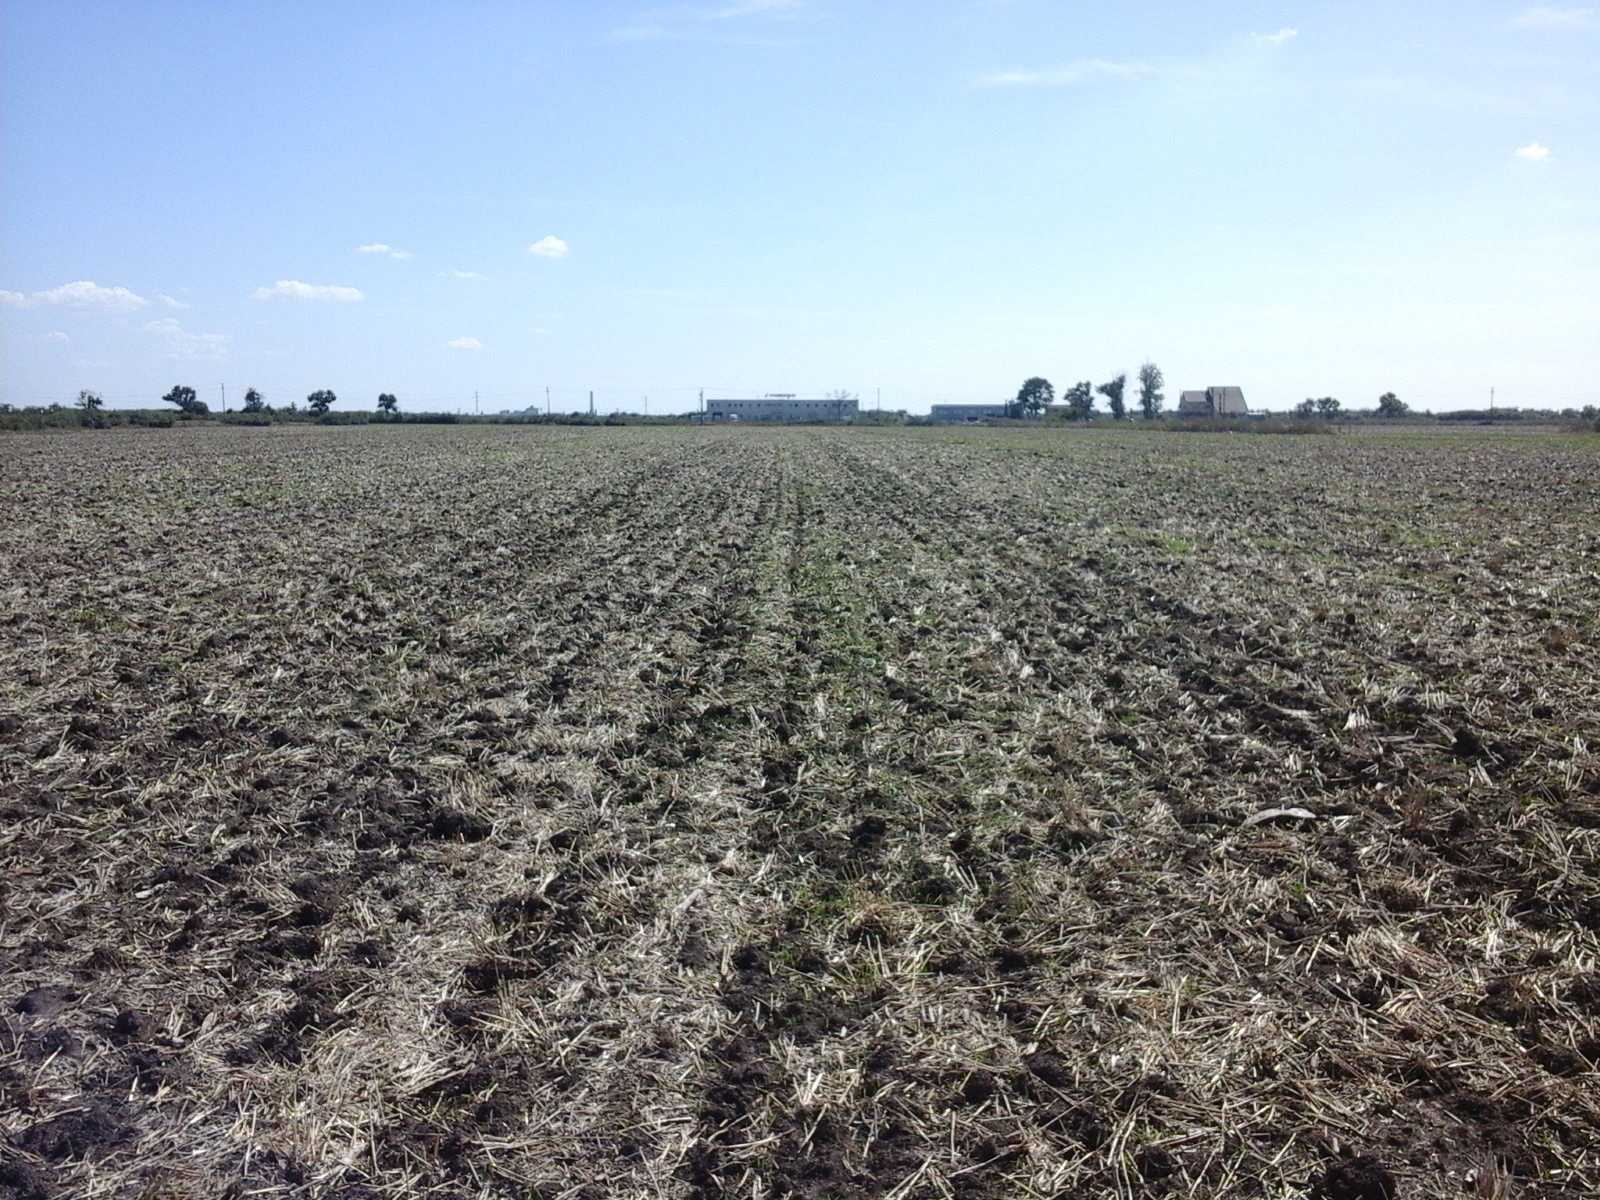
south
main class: Cropland
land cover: Common wheat
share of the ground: < 10 %
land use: Agriculture (excluding fallow land and kitchen gardens)
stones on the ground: < 10 %
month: August
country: RO
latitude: 45.7661
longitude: 21.1522
